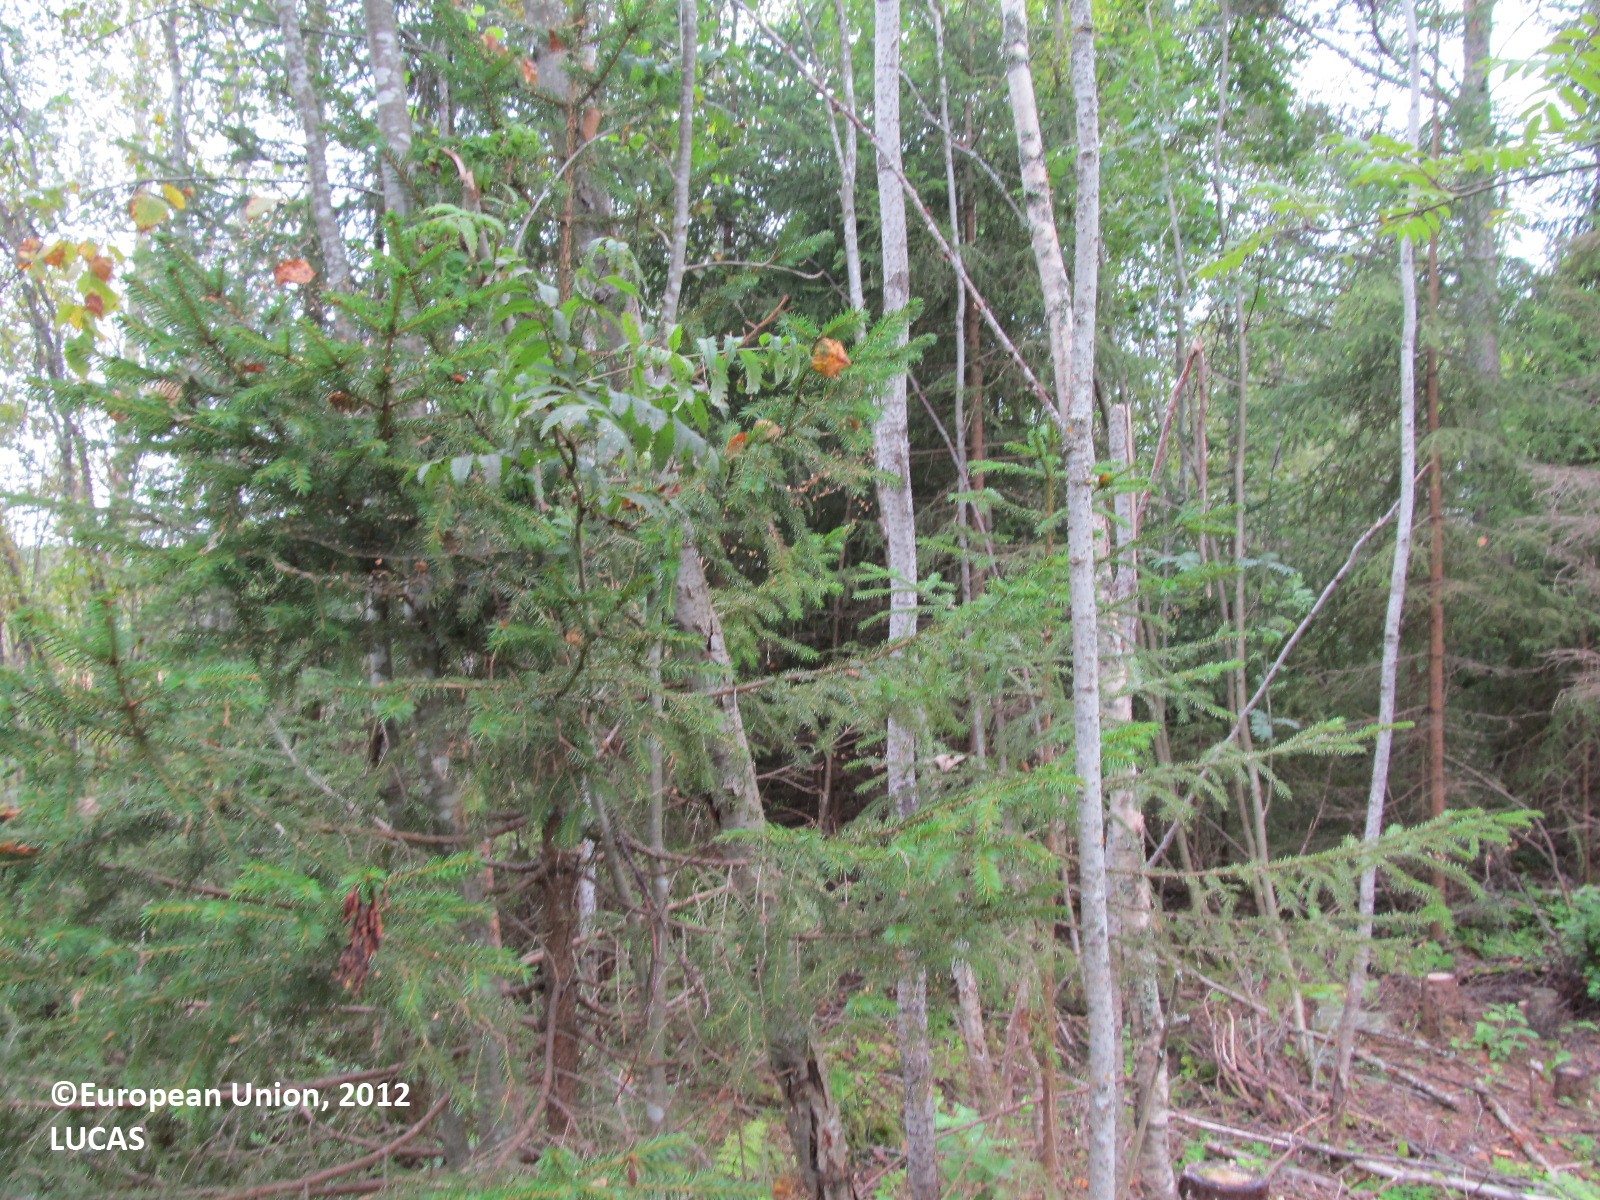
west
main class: Woodland
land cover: Pine dominated mixed woodland
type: boreal forest
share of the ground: 25 - 50 %
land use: Forestry
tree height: > 5 m
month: August
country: FI
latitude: 63.1486
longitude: 27.8529
